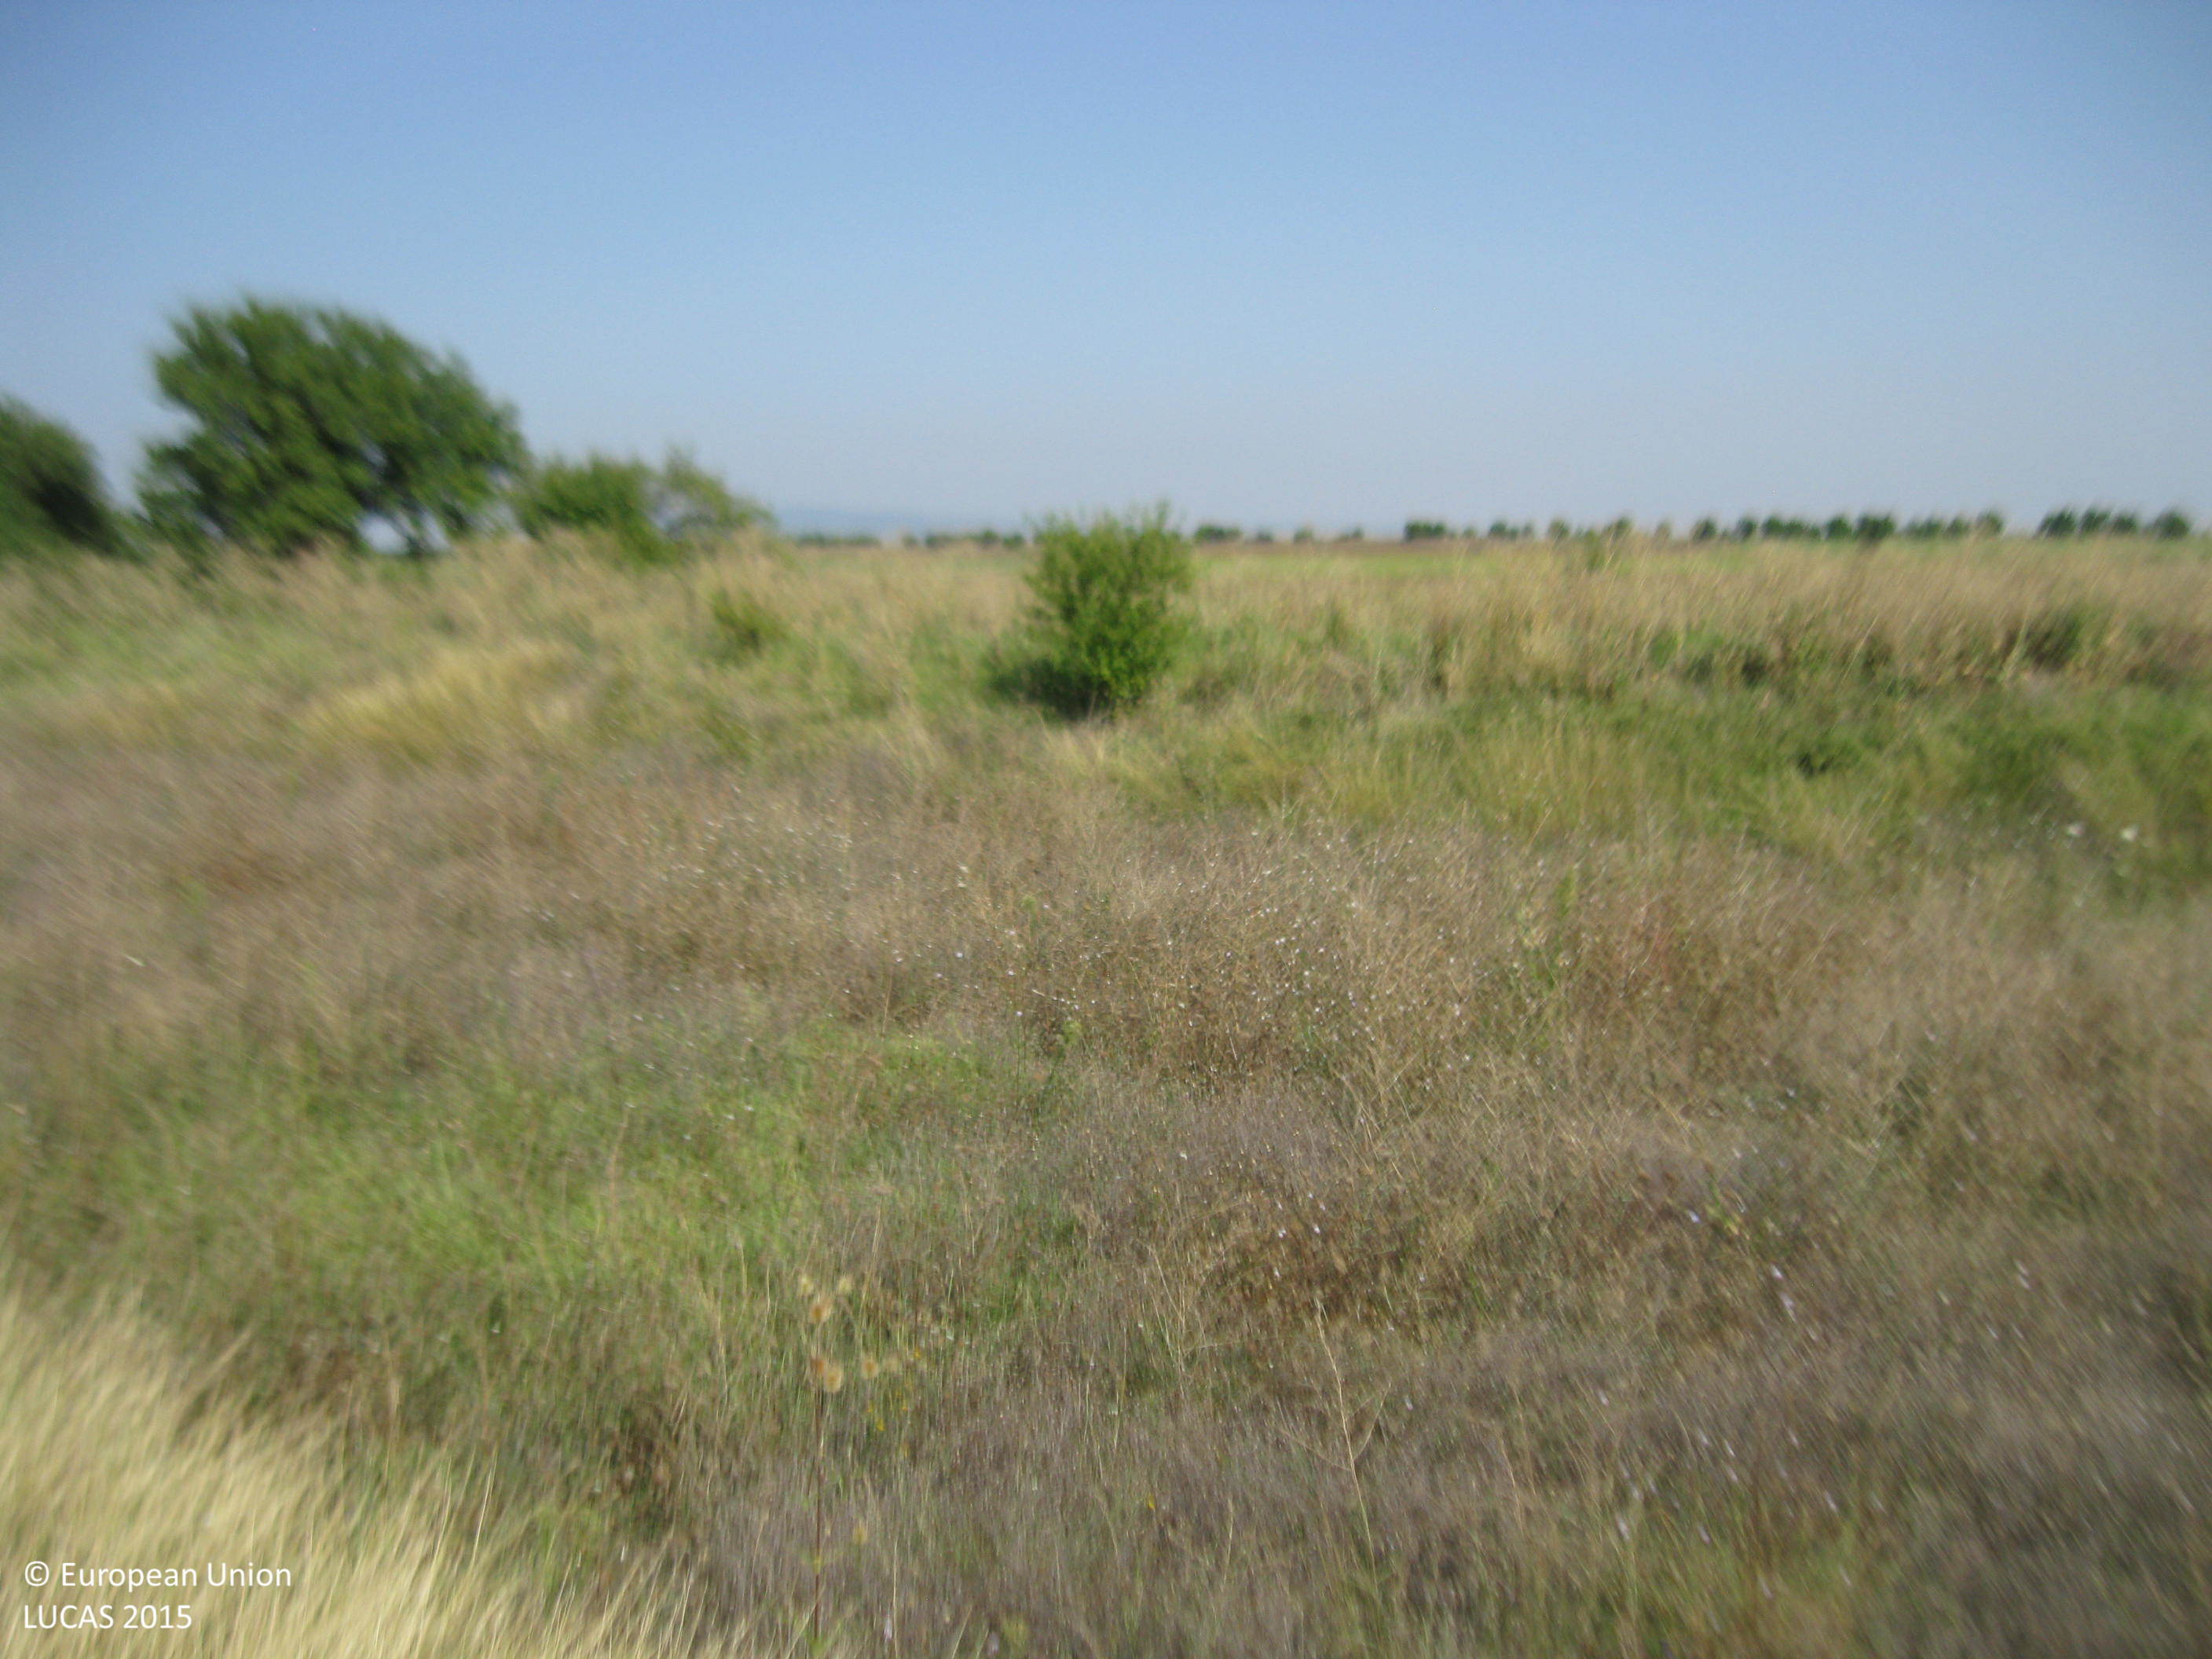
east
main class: Grassland
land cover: Grassland without tree/shrub cover
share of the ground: > 75 %
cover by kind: herbaceous plants 100 %
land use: Semi-natural and natural areas not in use
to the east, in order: Grassland without tree/shrub cover; Sunflower; Common wheat; Grass margins; Tracks; Grassland without tree/shrub cover
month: September
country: BG
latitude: 42.2552
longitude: 25.0525
